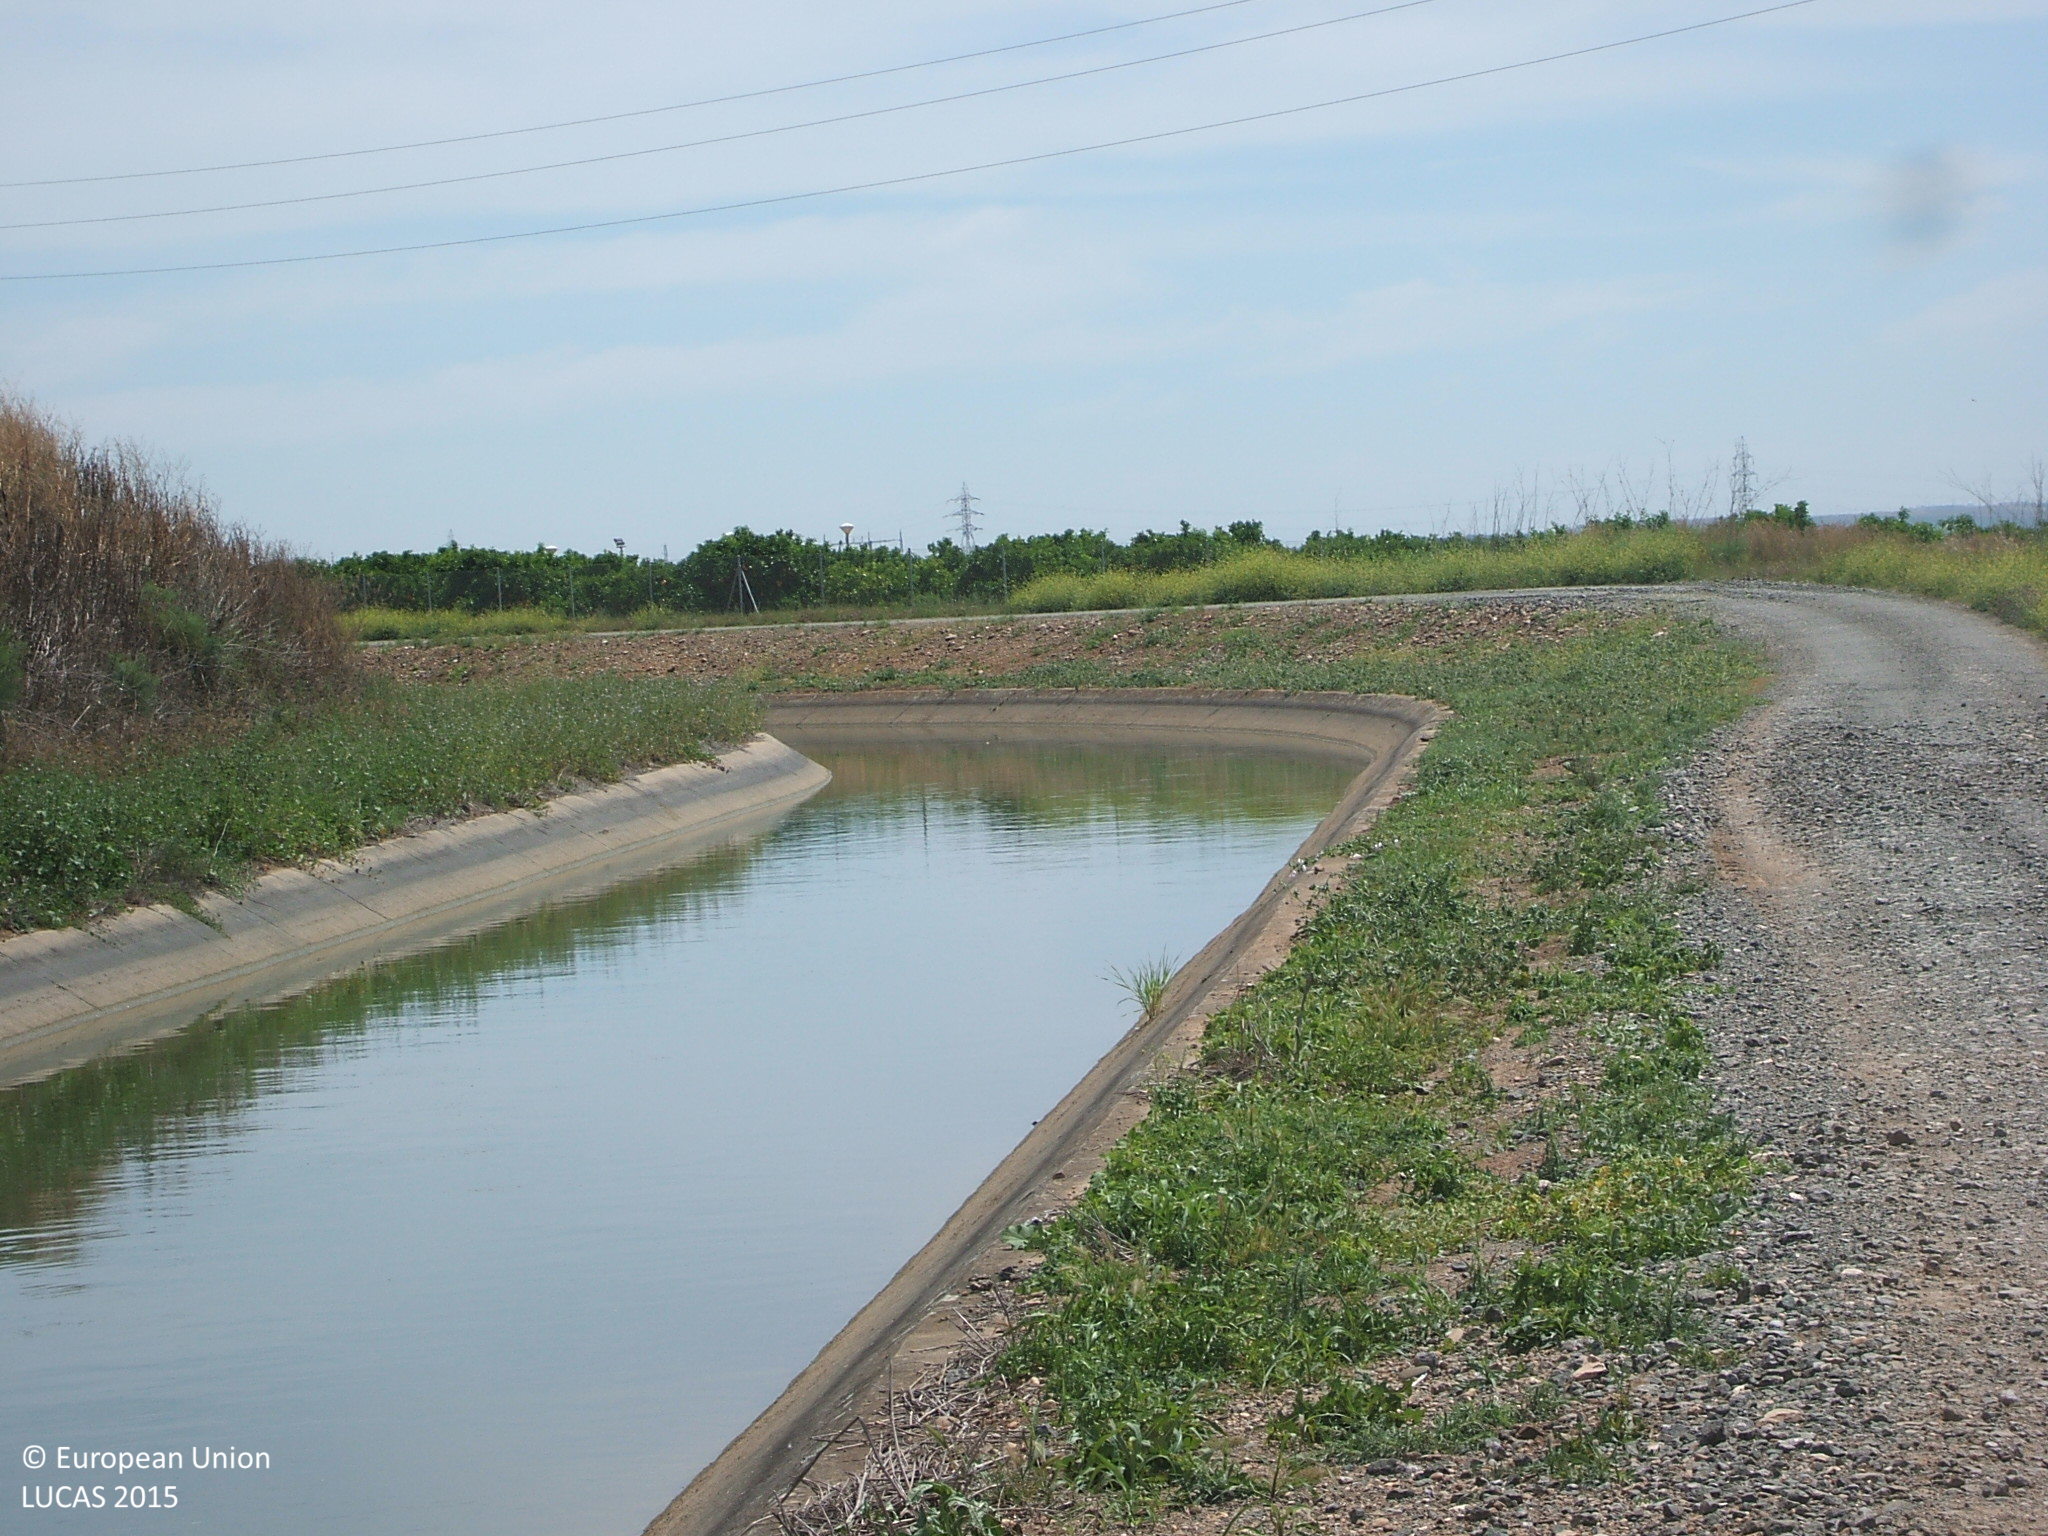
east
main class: Cropland
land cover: Sunflower
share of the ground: > 75 %
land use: Agriculture (excluding fallow land and kitchen gardens)
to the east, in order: Sunflower; Abandoned hedges; Grass margins; Inland fresh running water
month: May
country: ES
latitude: 37.7127
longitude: -5.4371
